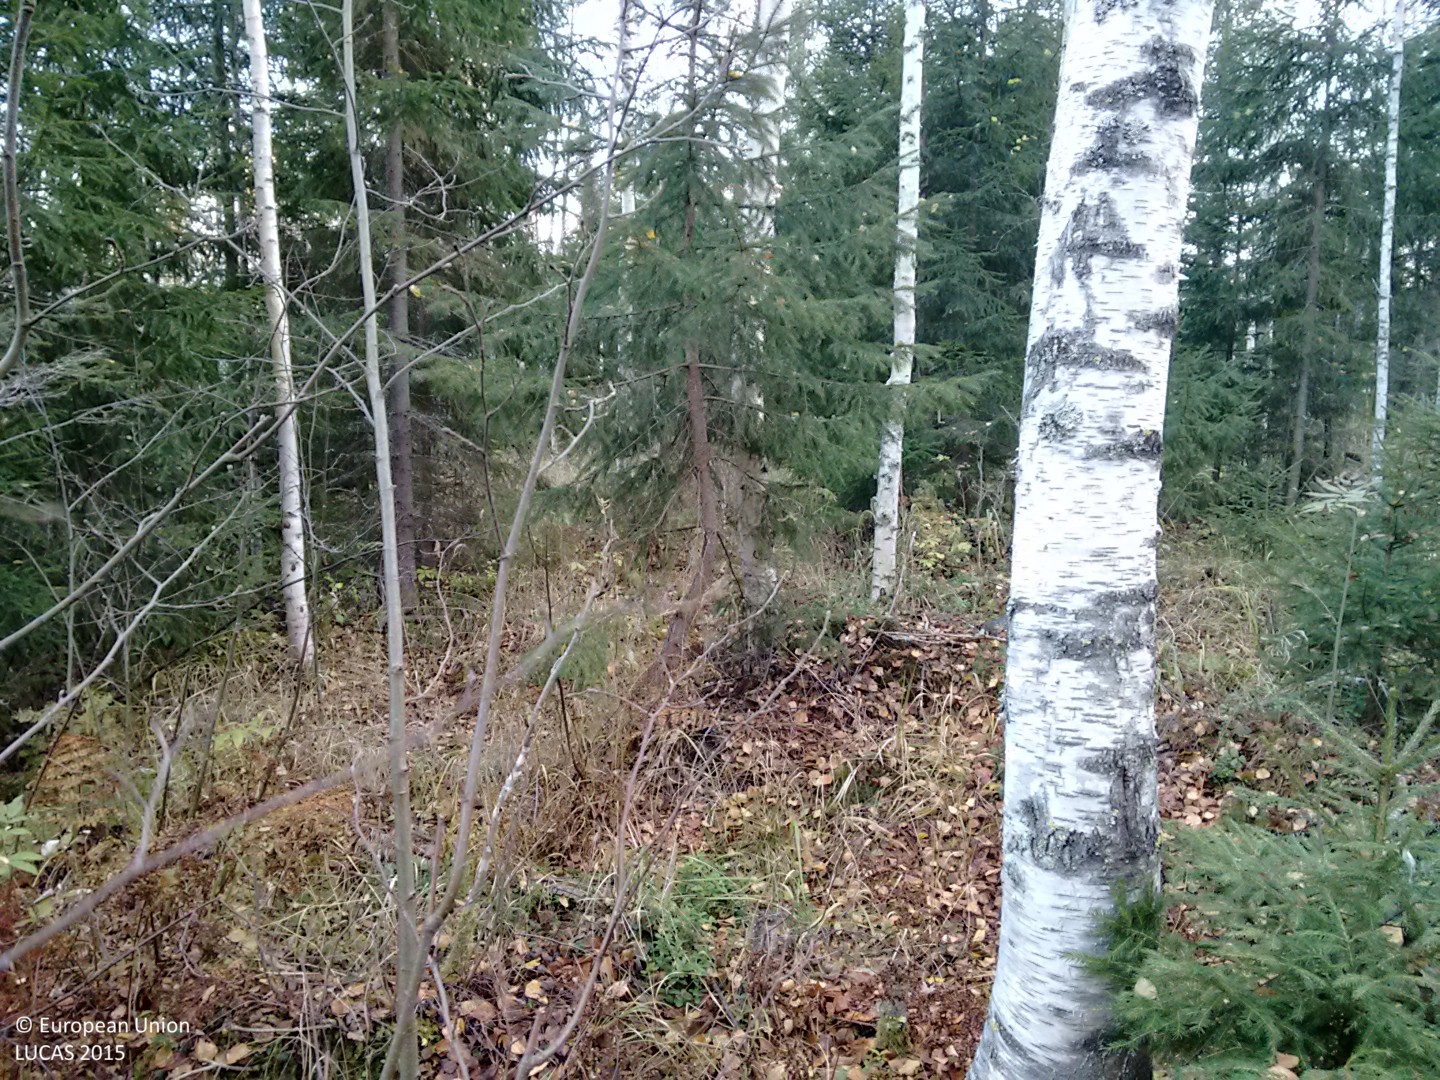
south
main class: Woodland
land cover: Spruce dominated mixed woodland
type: boreal forest
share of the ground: > 75 %
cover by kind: broadleaved forest trees 45 %, coniferous forest trees 40 %, shrubs 10 %, herbaceous plants 5 %
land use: Forestry
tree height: > 5 m
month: October
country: FI
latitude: 62.8430
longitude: 26.1292
